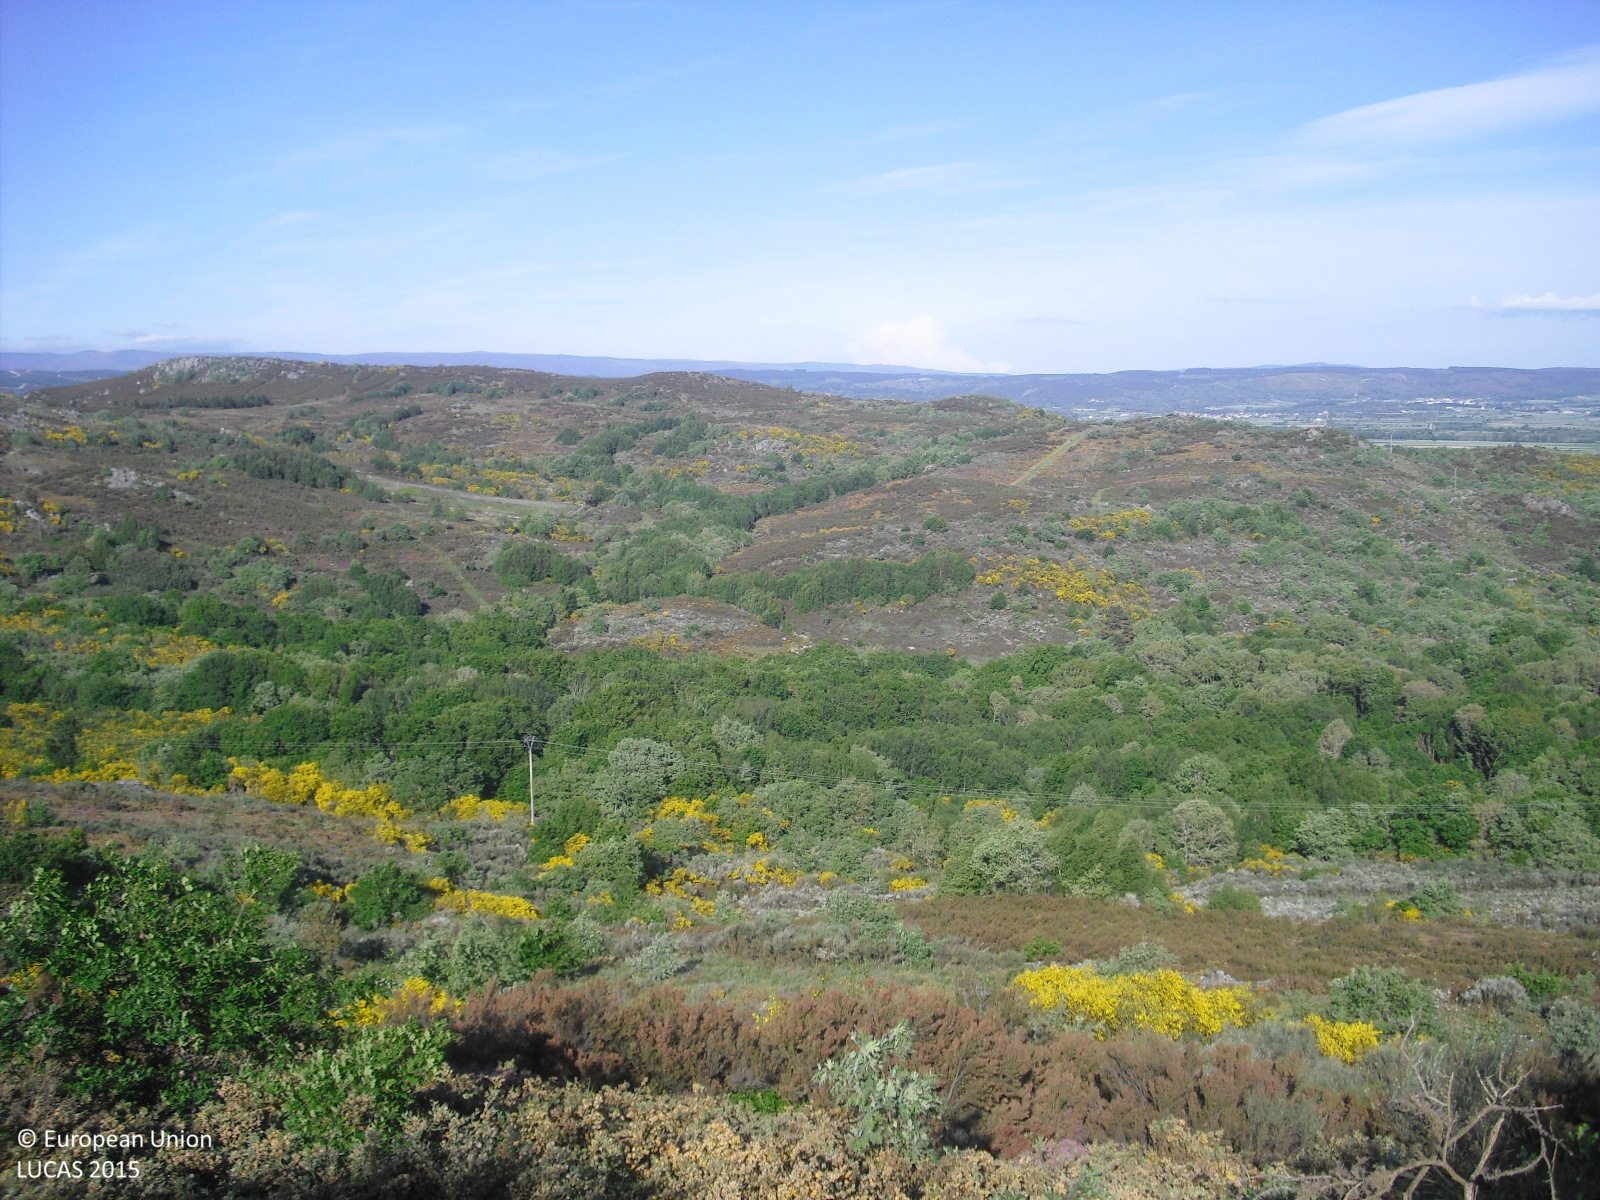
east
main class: Shrubland
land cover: Shrubland with sparse tree cover
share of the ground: > 75 %
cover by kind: shrubs 85 %, consolidated bare surface 10 %, broadleaved forest trees 5 %
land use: Semi-natural and natural areas not in use
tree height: > 5 m
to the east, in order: Shrubland with sparse tree cover; Rock outcrops; Shrubland without tree cover; Tracks; Shrubland without tree cover; Rock outcrops; Shrubland without tree cover; Rock outcrops; Shrubland without tree cover; Dry stone walls; Shrubland without tree cover; Dry stone walls; Shrubland without tree cover; Rock outcrops; Shrubland with sparse tree cover; Broadleaved woodland; Shrubland without tree cover; Dry stone walls; Shrubland without tree cover; Electric lines; Shrubland without tree cover; Dry stone walls; Broadleaved woodland
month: May
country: ES
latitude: 42.0799
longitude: -7.6805
